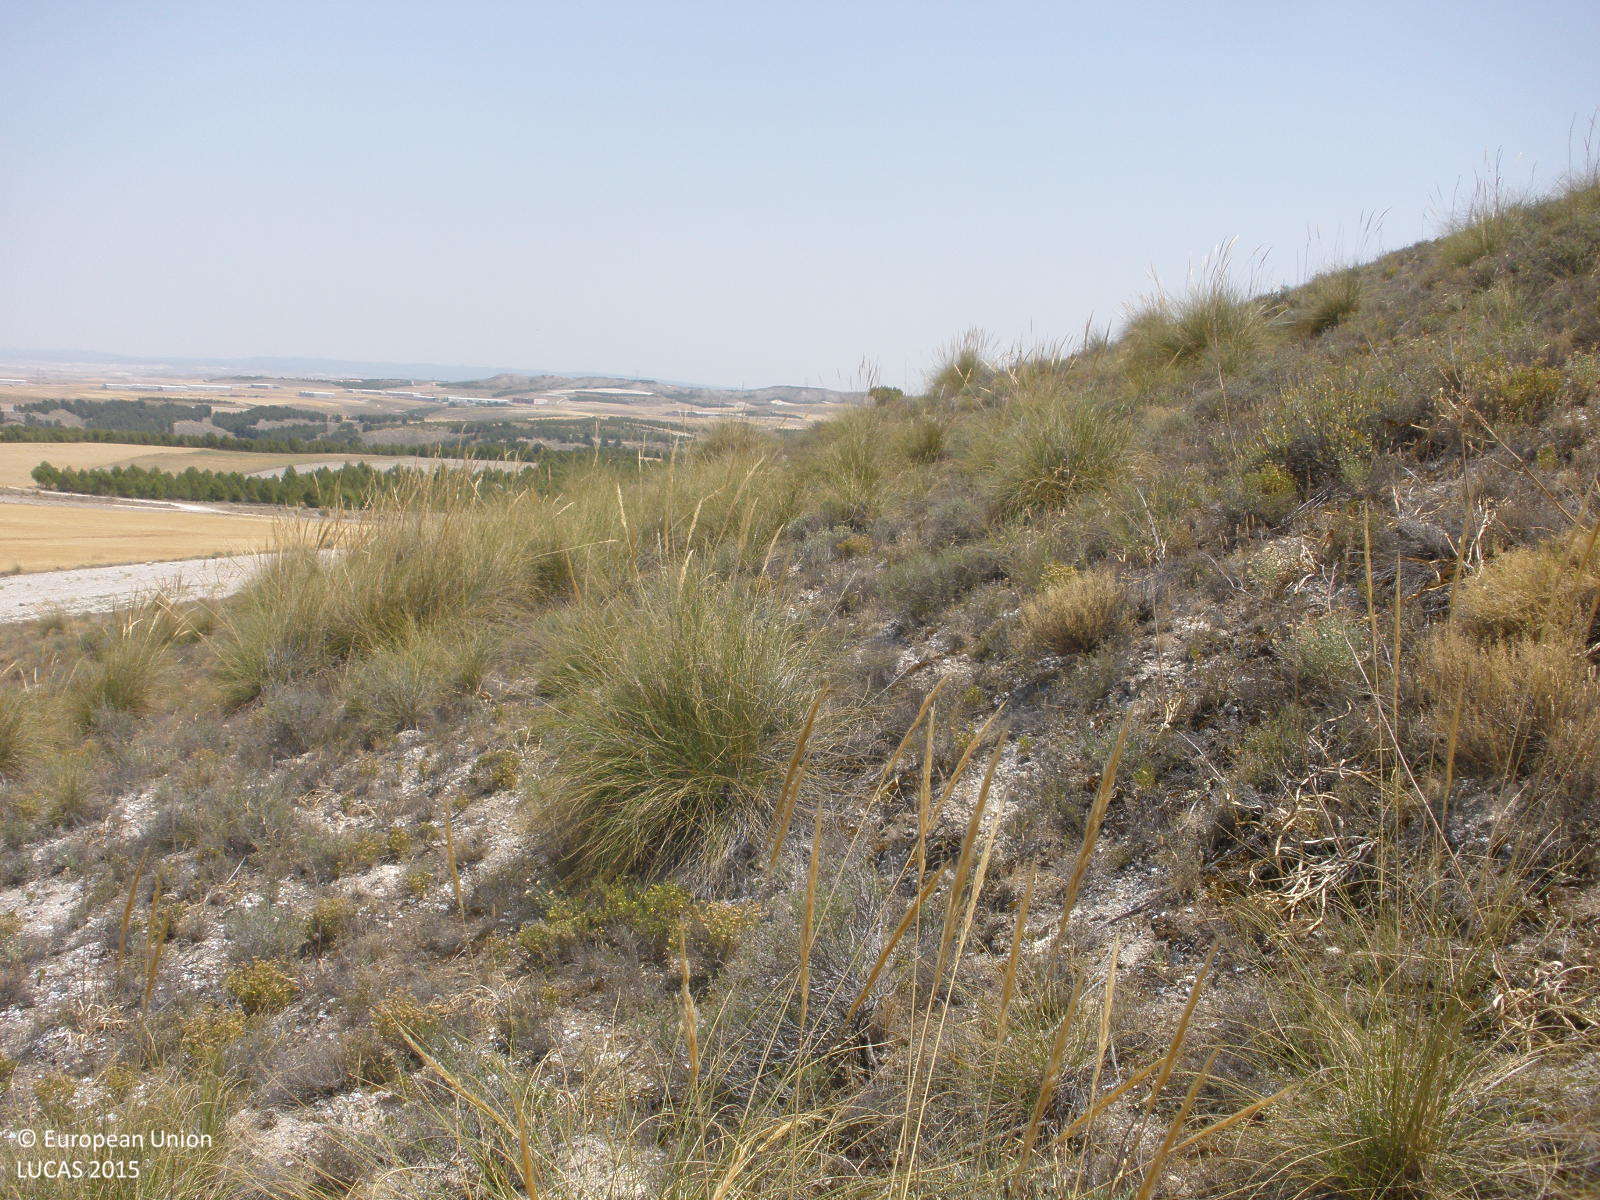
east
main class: Shrubland
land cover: Shrubland without tree cover
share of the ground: 25 - 50 %
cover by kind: herbaceous plants 50 %, shrubs 40 %, consolidated bare surface 10 %
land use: Semi-natural and natural areas not in use
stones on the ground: < 10 %
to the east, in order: Shrubland without tree cover; Other bare soil; Shrubland without tree cover; Other bare soil; Grass margins; Barley
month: July
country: ES
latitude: 40.0352
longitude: -3.1632
